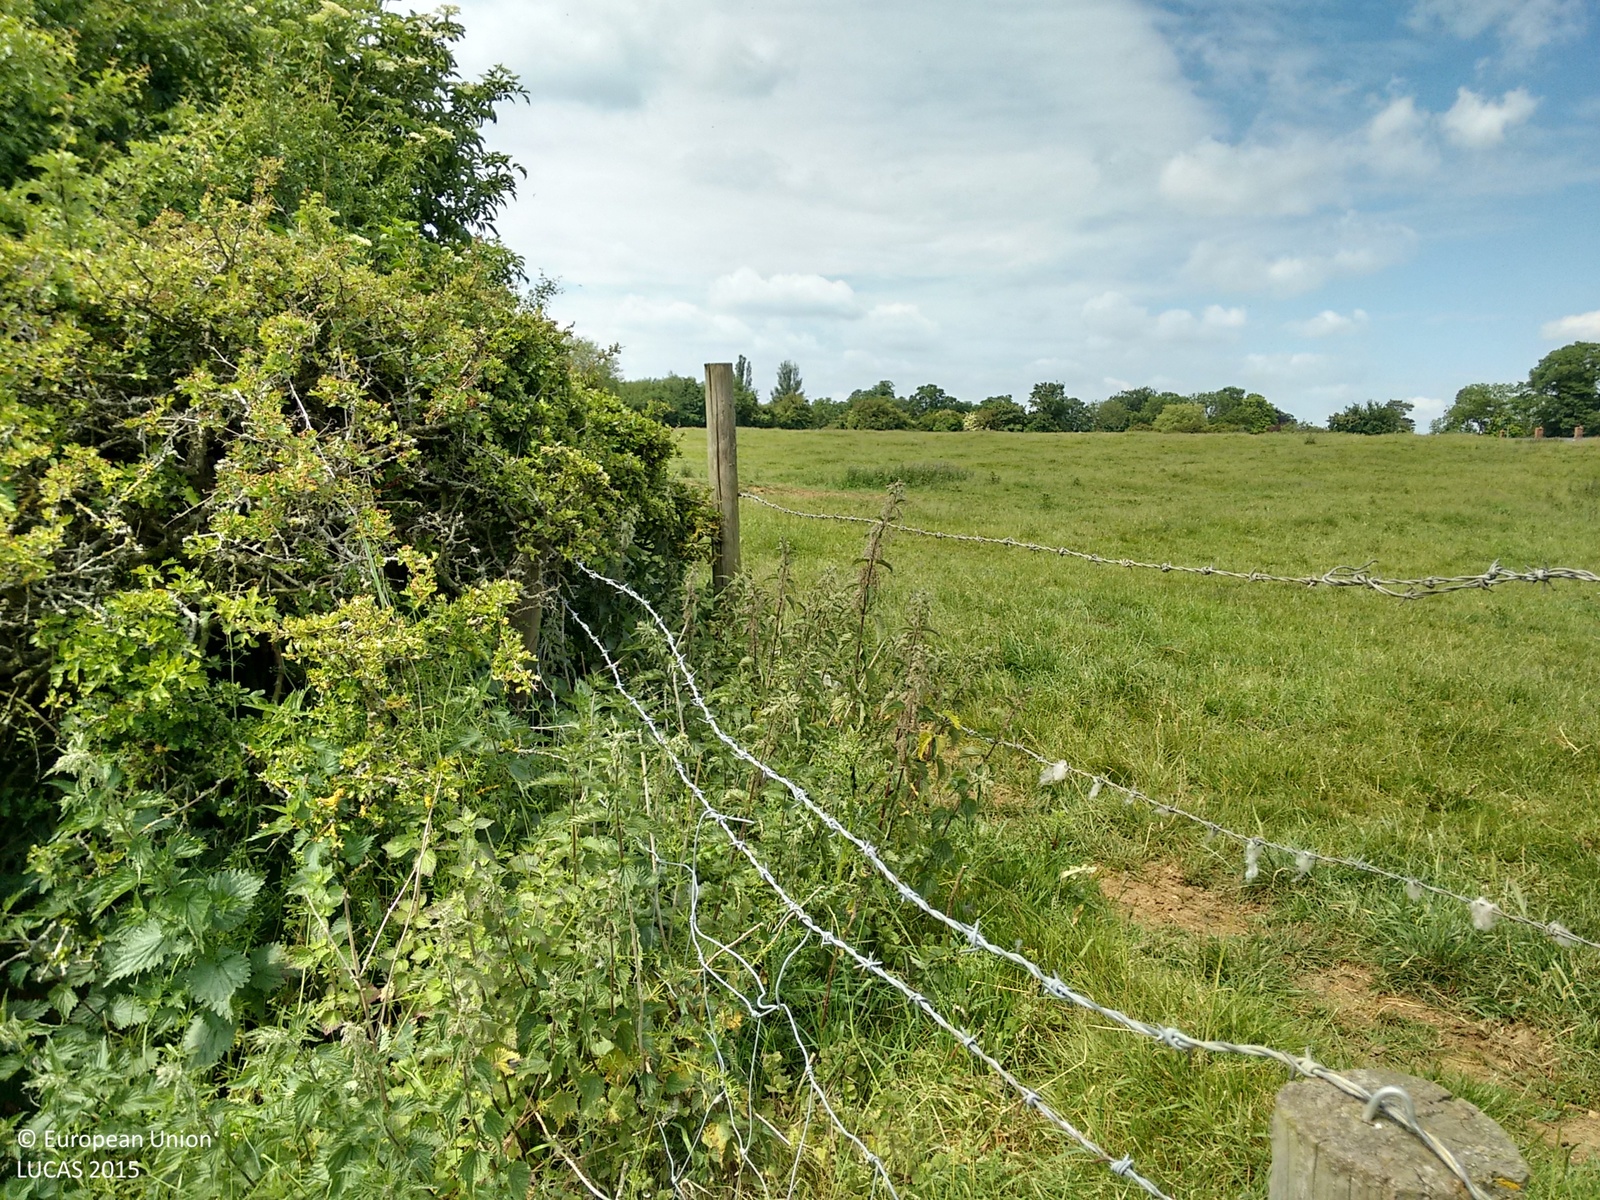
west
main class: Grassland
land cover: Grassland without tree/shrub cover
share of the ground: > 75 %
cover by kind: herbaceous plants 100 %
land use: Agriculture (excluding fallow land and kitchen gardens)
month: June
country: GB
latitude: 52.0423
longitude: -0.8459
